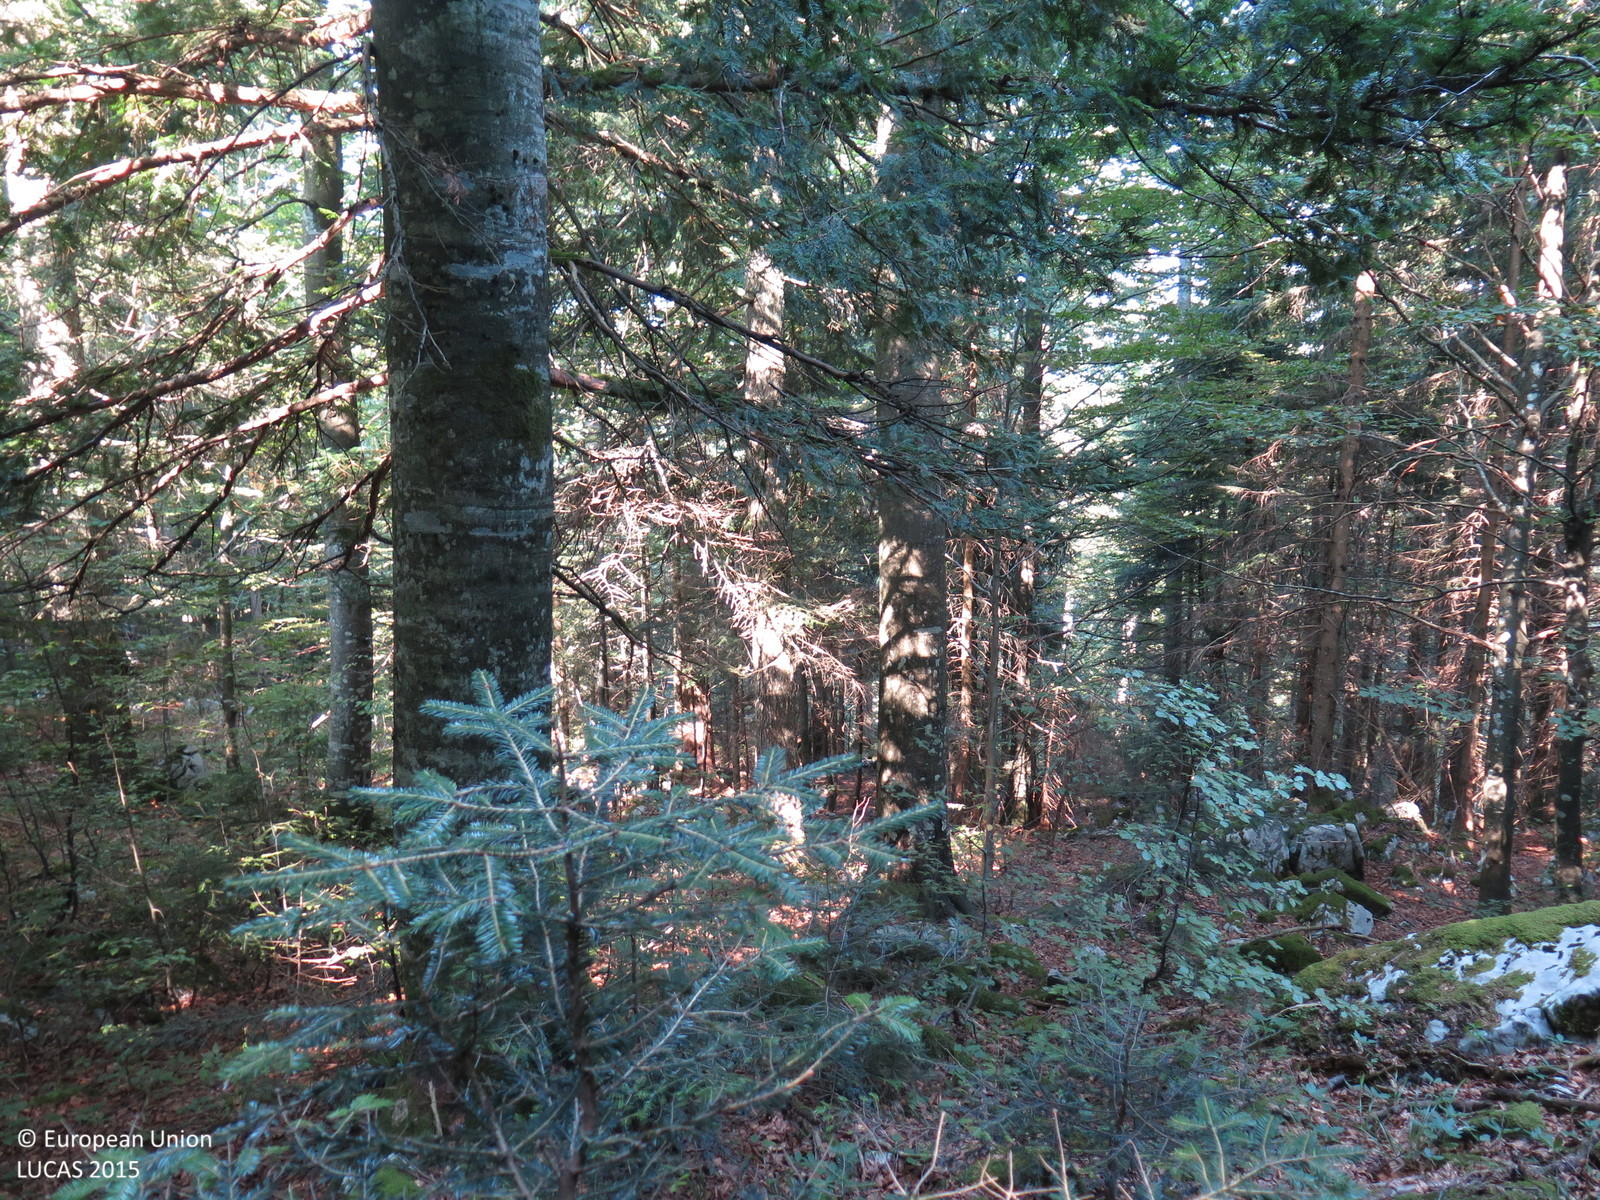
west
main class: Woodland
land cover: Other mixed woodland
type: alpine coniferous forest
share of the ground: > 75 %
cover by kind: coniferous forest trees 75 %, broadleaved forest trees 25 %
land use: Forestry
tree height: > 5 m
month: August
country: HR
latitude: 45.3517
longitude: 14.9605
